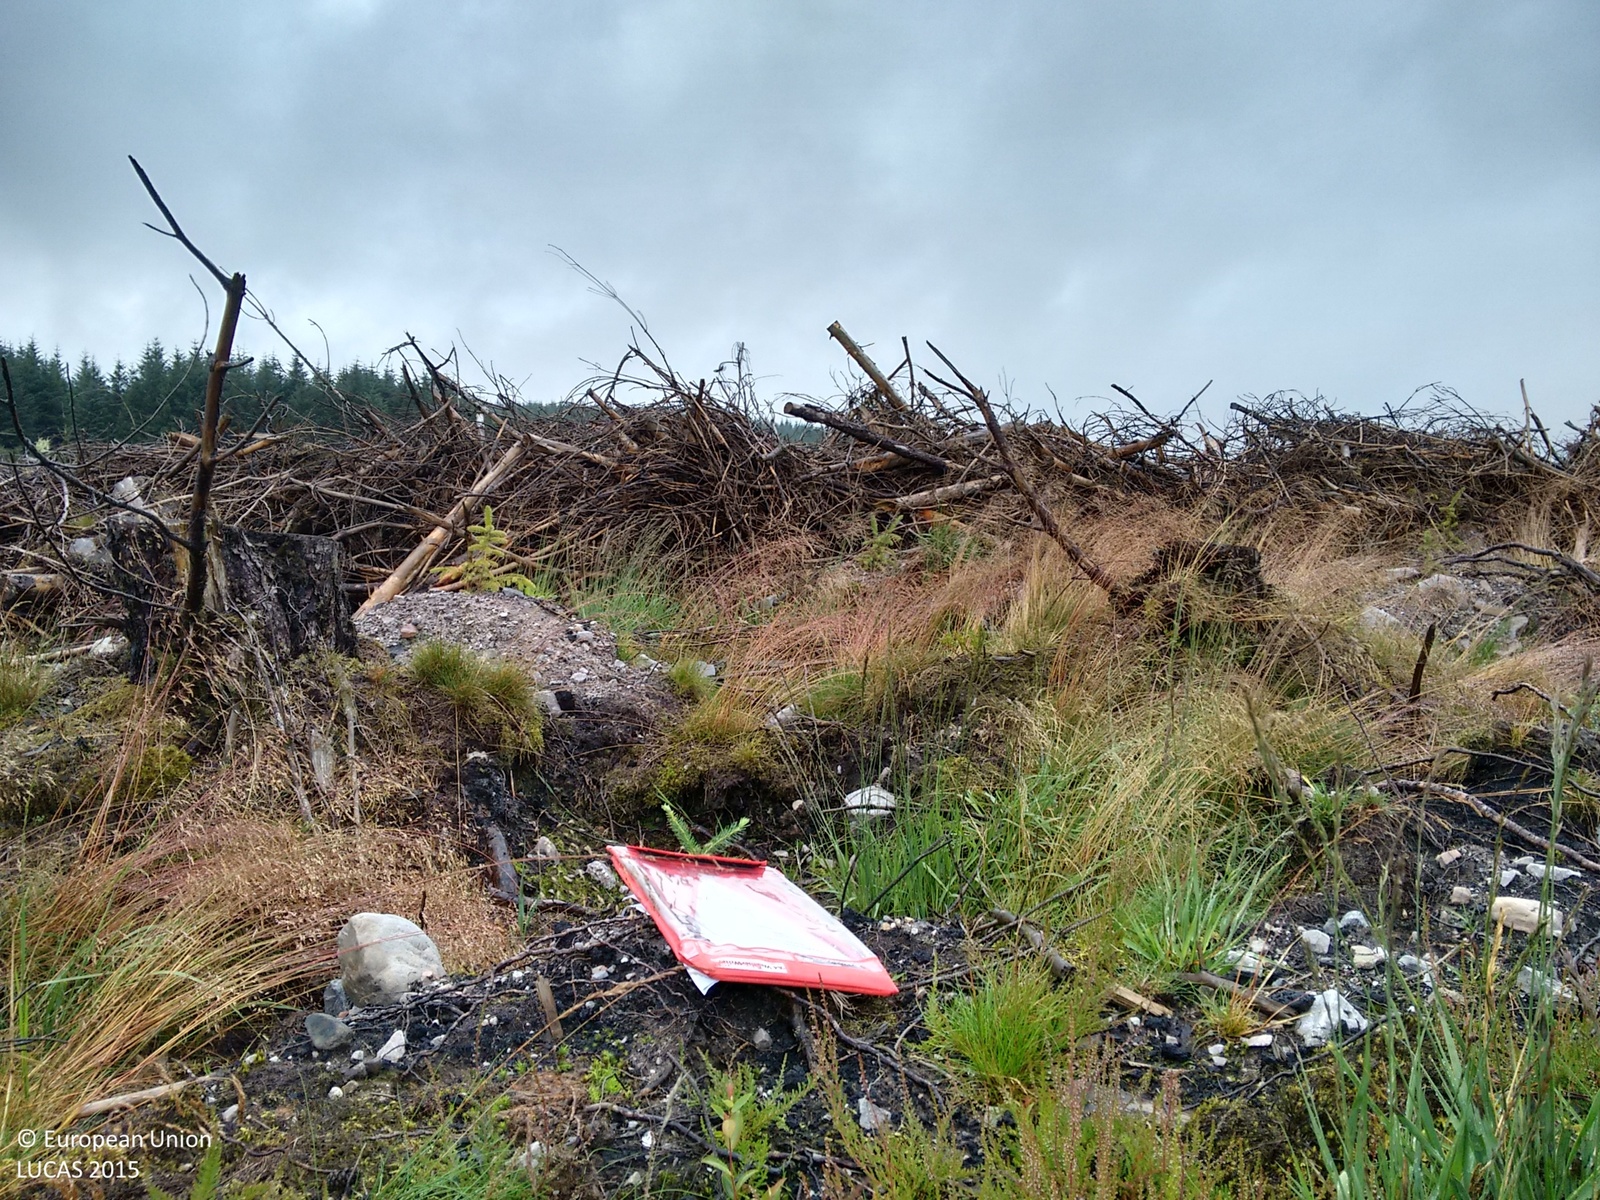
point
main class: Grassland
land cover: Spontaneously vegetated surfaces
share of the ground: > 75 %
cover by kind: herbaceous plants 70 %, unconsolidated bare surface 30 %
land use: Forestry
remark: Clear cut
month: July
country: GB
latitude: 51.8034
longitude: -3.6470
